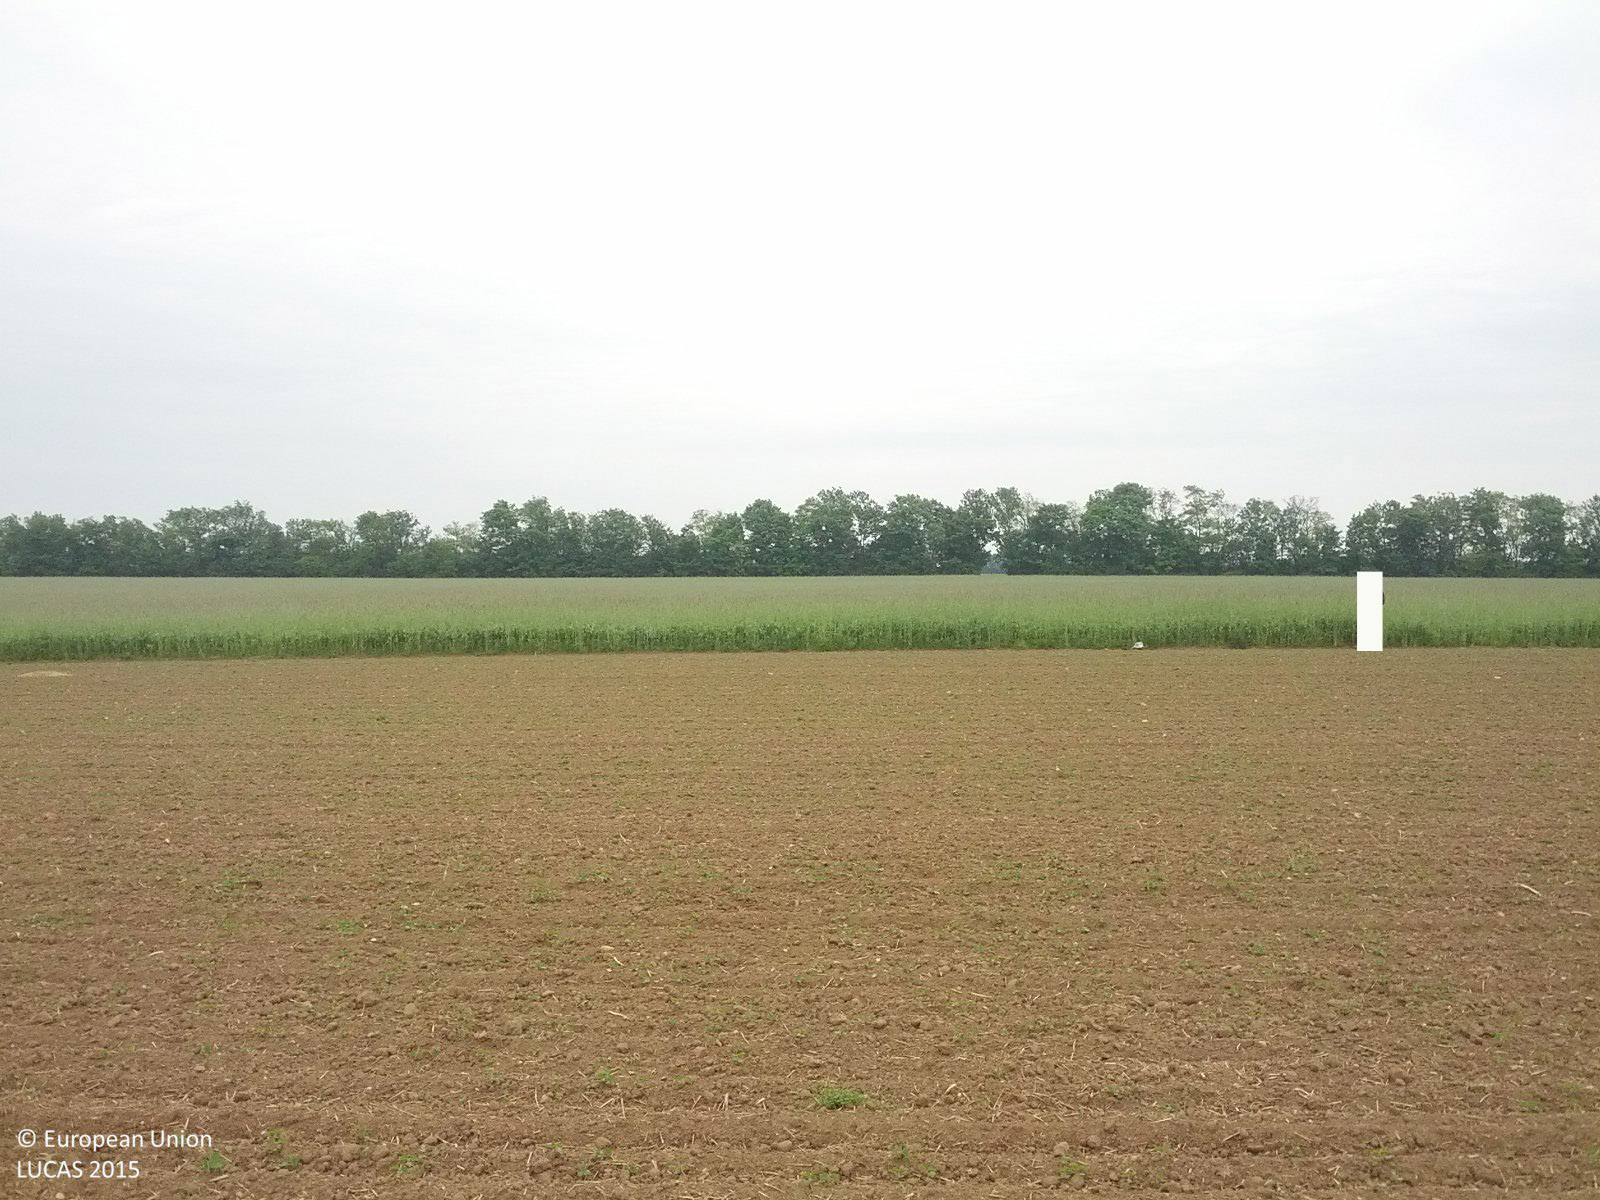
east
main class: Cropland
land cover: Soya
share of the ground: < 10 %
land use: Agriculture (excluding fallow land and kitchen gardens)
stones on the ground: < 10 %
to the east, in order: Soya; Rye; Broadleaved woodland; Tracks; Grass margins; Other bare soil
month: May
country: AT
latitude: 48.1062
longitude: 16.7616
